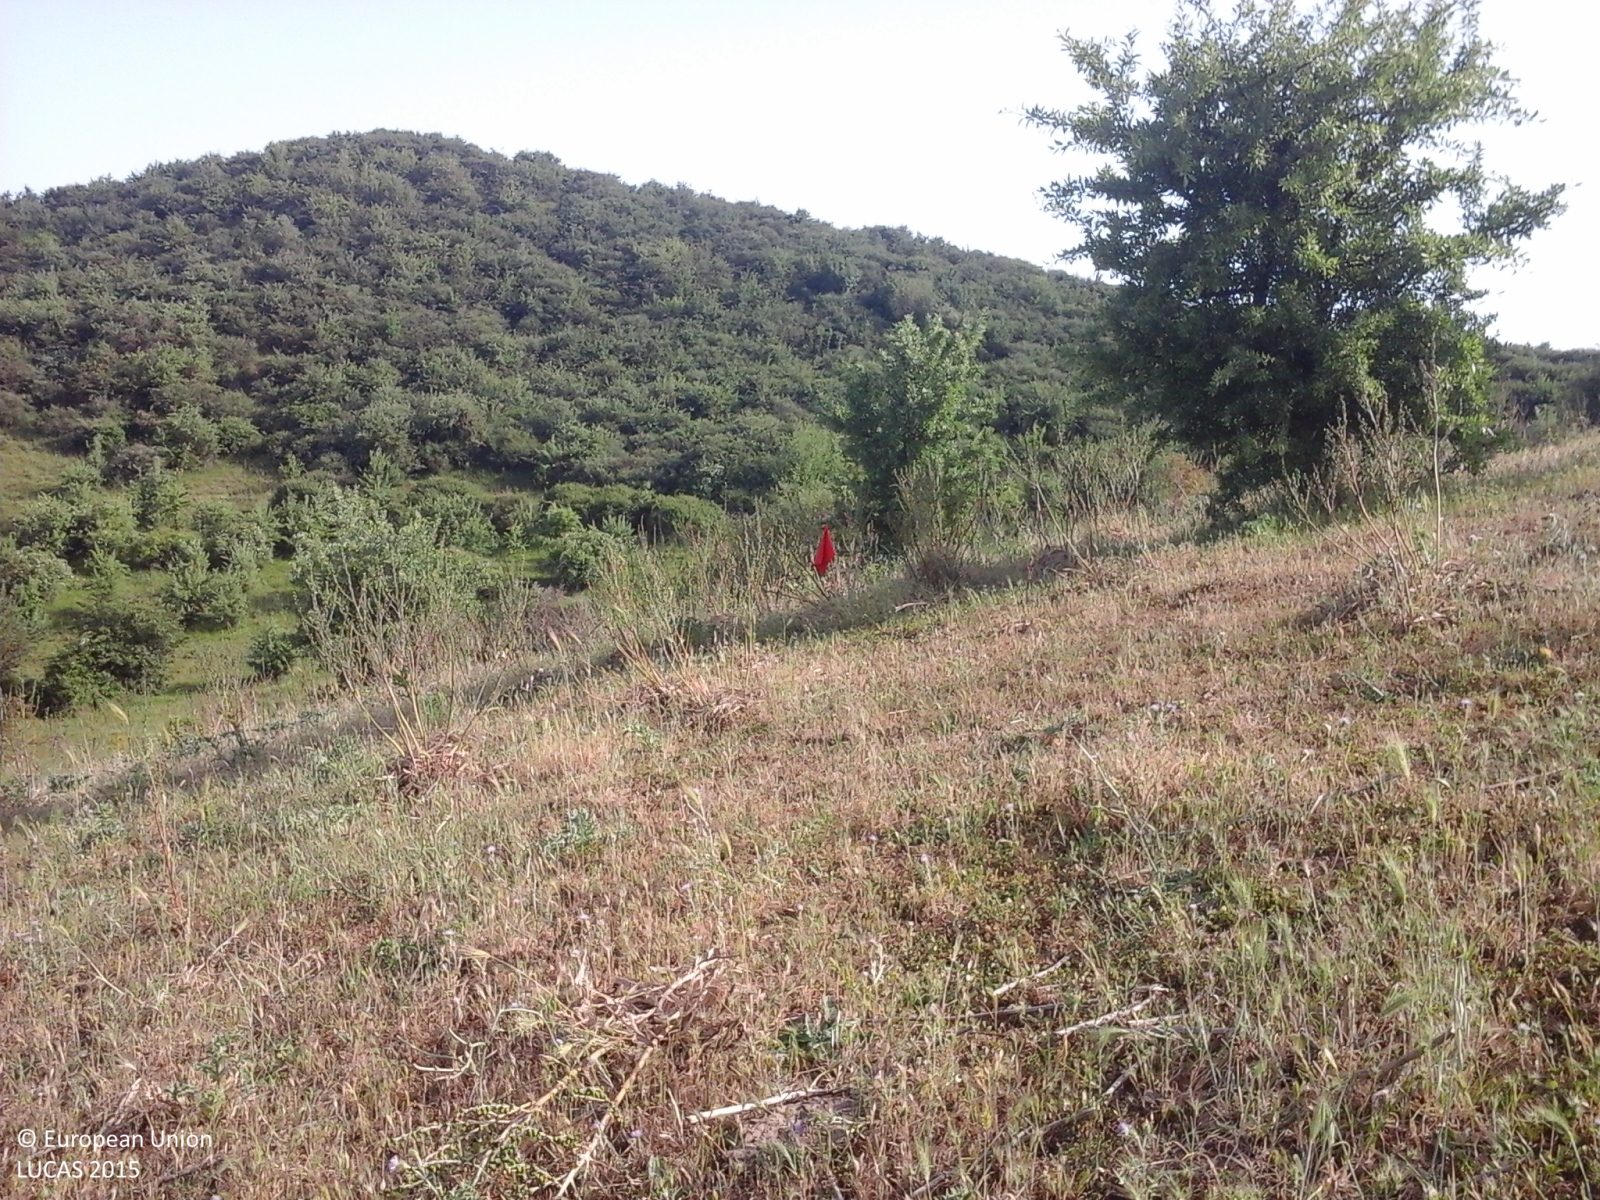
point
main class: Grassland
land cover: Grassland with sparse tree/shrub cover
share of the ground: > 75 %
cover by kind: herbaceous plants 90 %, broadleaved forest trees 5 %, shrubs 5 %
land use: Agriculture (excluding fallow land and kitchen gardens)
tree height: < 5 m
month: May
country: IT
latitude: 37.6979
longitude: 14.0422
